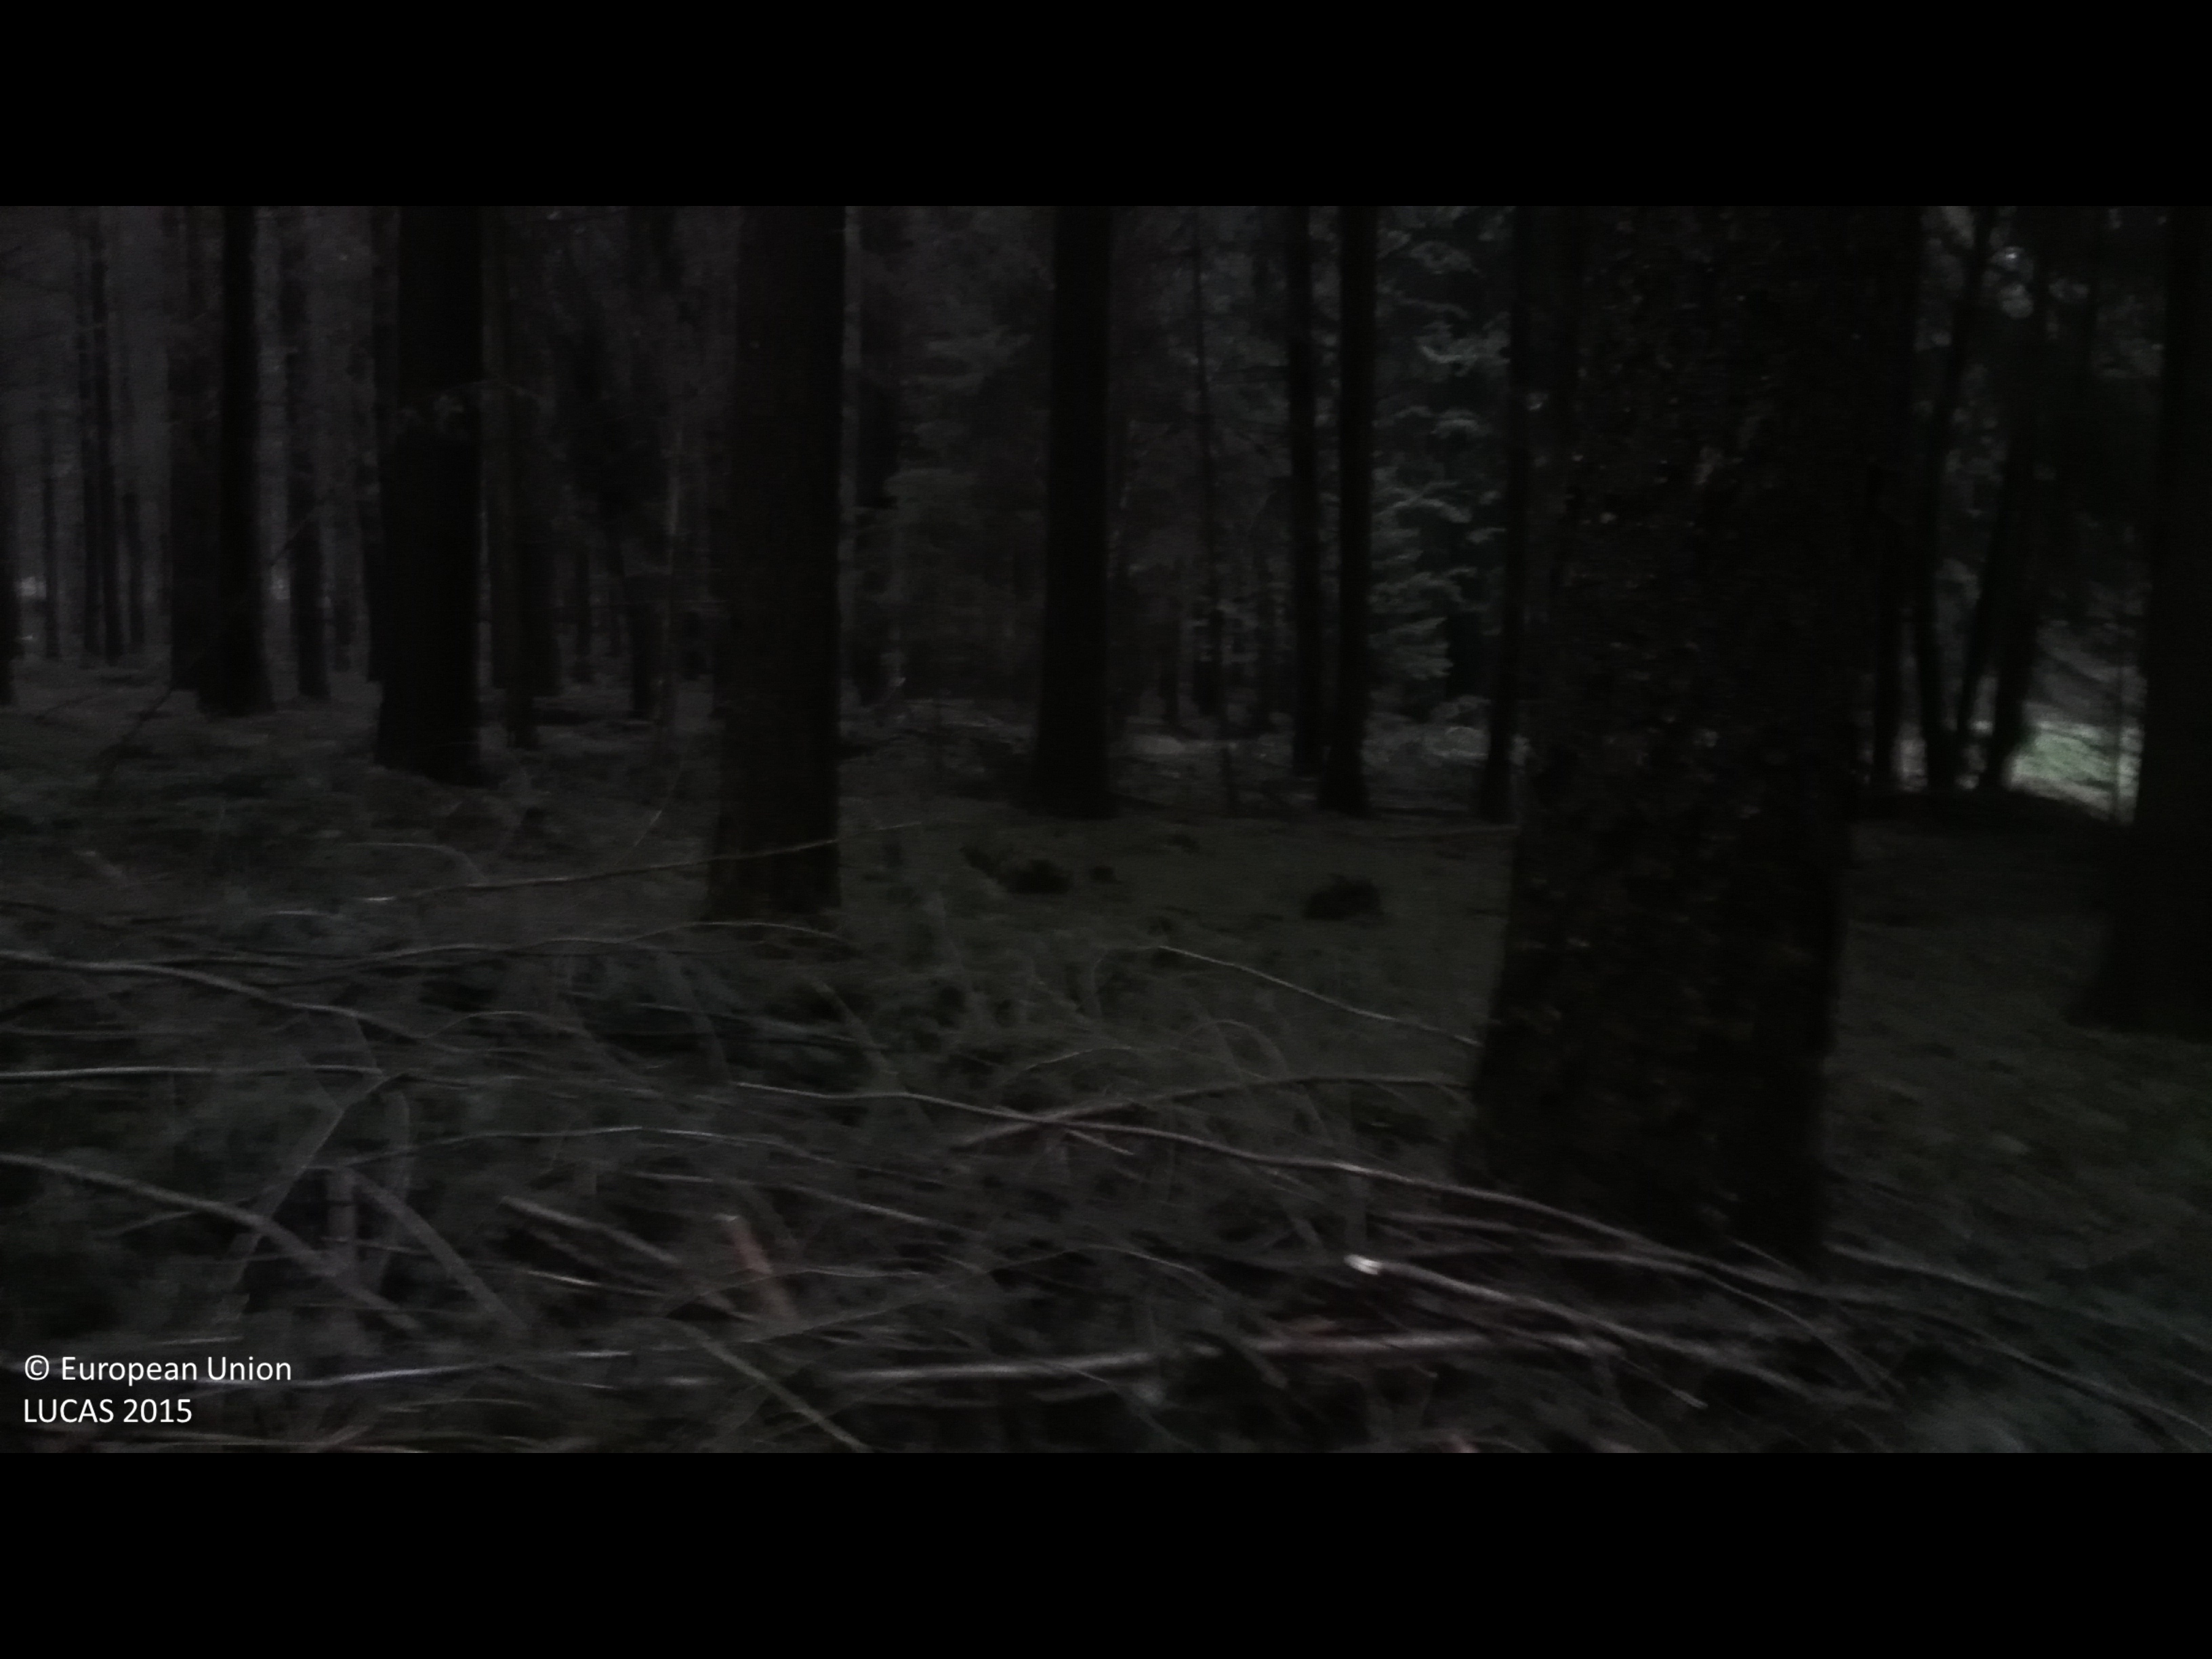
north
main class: Woodland
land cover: Pine dominated coniferous woodland
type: hemiboreal forest and nemoral coniferous forest and mixed broadleaved-coniferous forest
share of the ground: > 75 %
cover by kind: coniferous forest trees 100 %
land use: Forestry
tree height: > 5 m
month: January
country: DE
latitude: 53.4199
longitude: 9.9248
